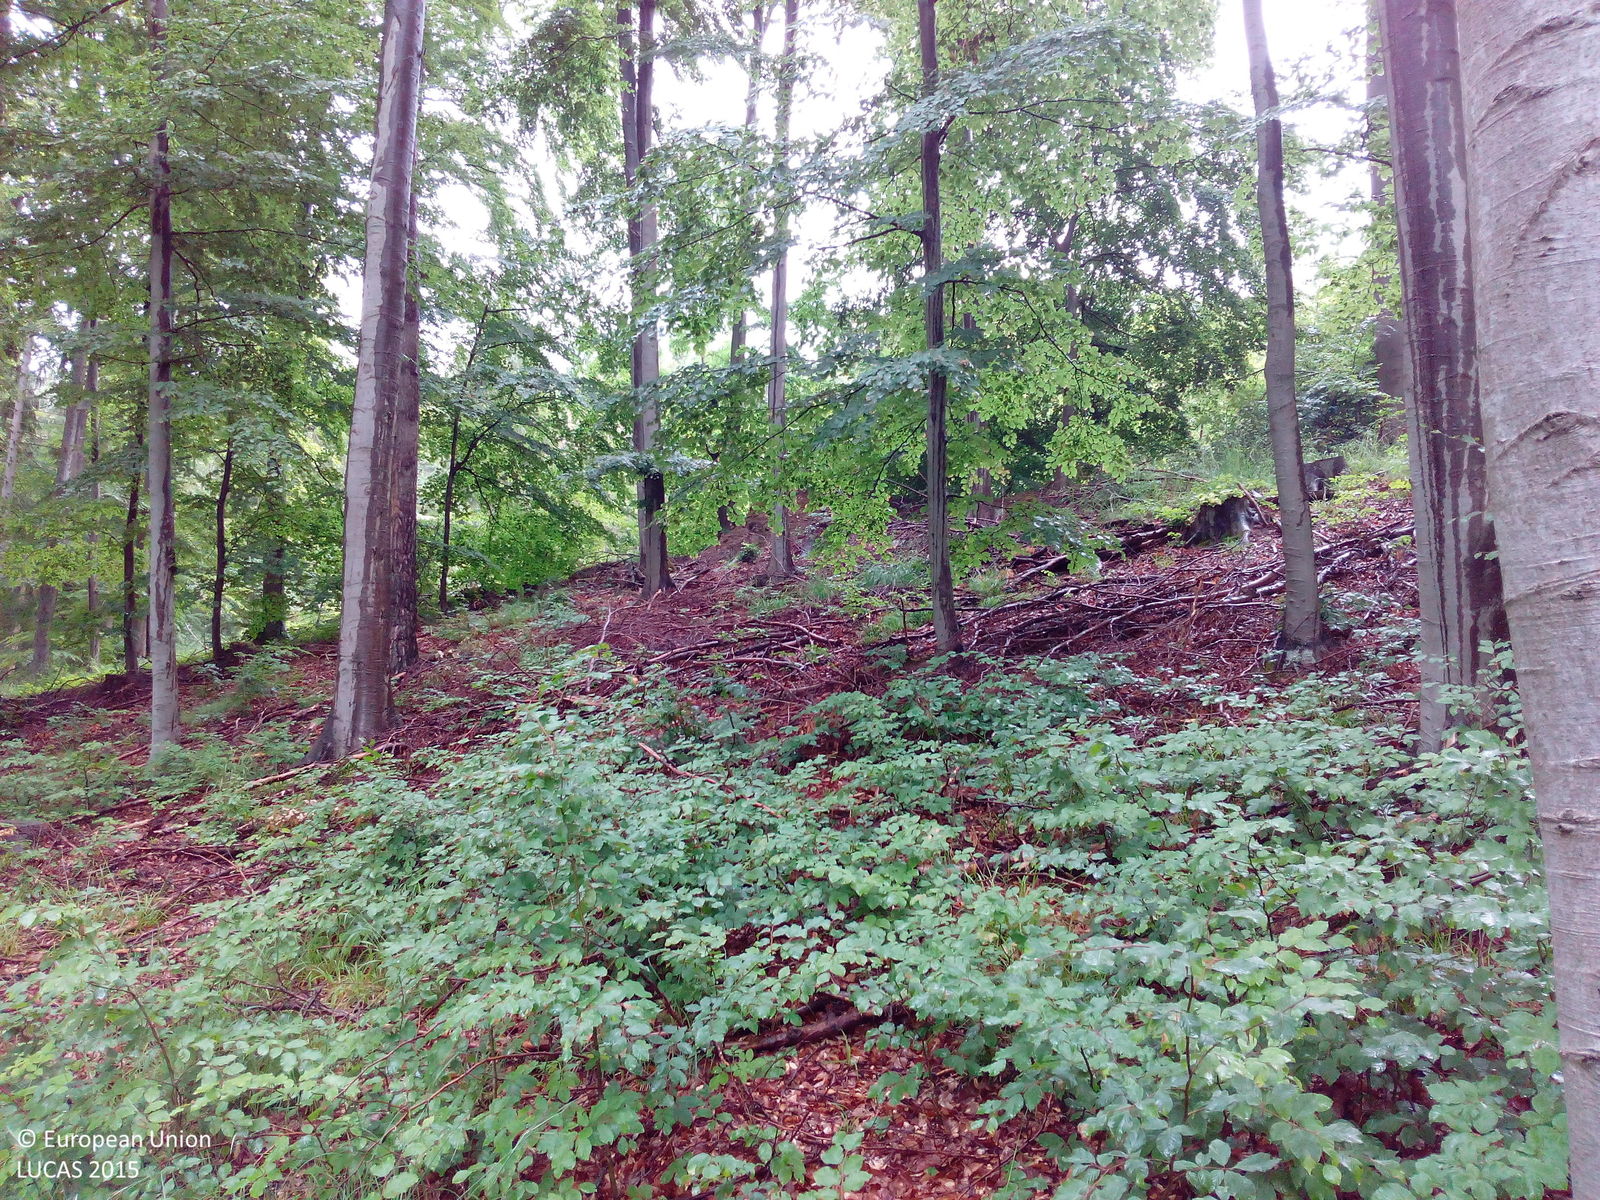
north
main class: Woodland
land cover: Broadleaved woodland
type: beech forest
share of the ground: > 75 %
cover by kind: broadleaved forest trees 90 %, herbaceous plants 10 %
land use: Forestry
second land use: Amenities, museums, leisure
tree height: > 5 m
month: June
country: DE
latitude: 51.9640
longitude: 9.8691
